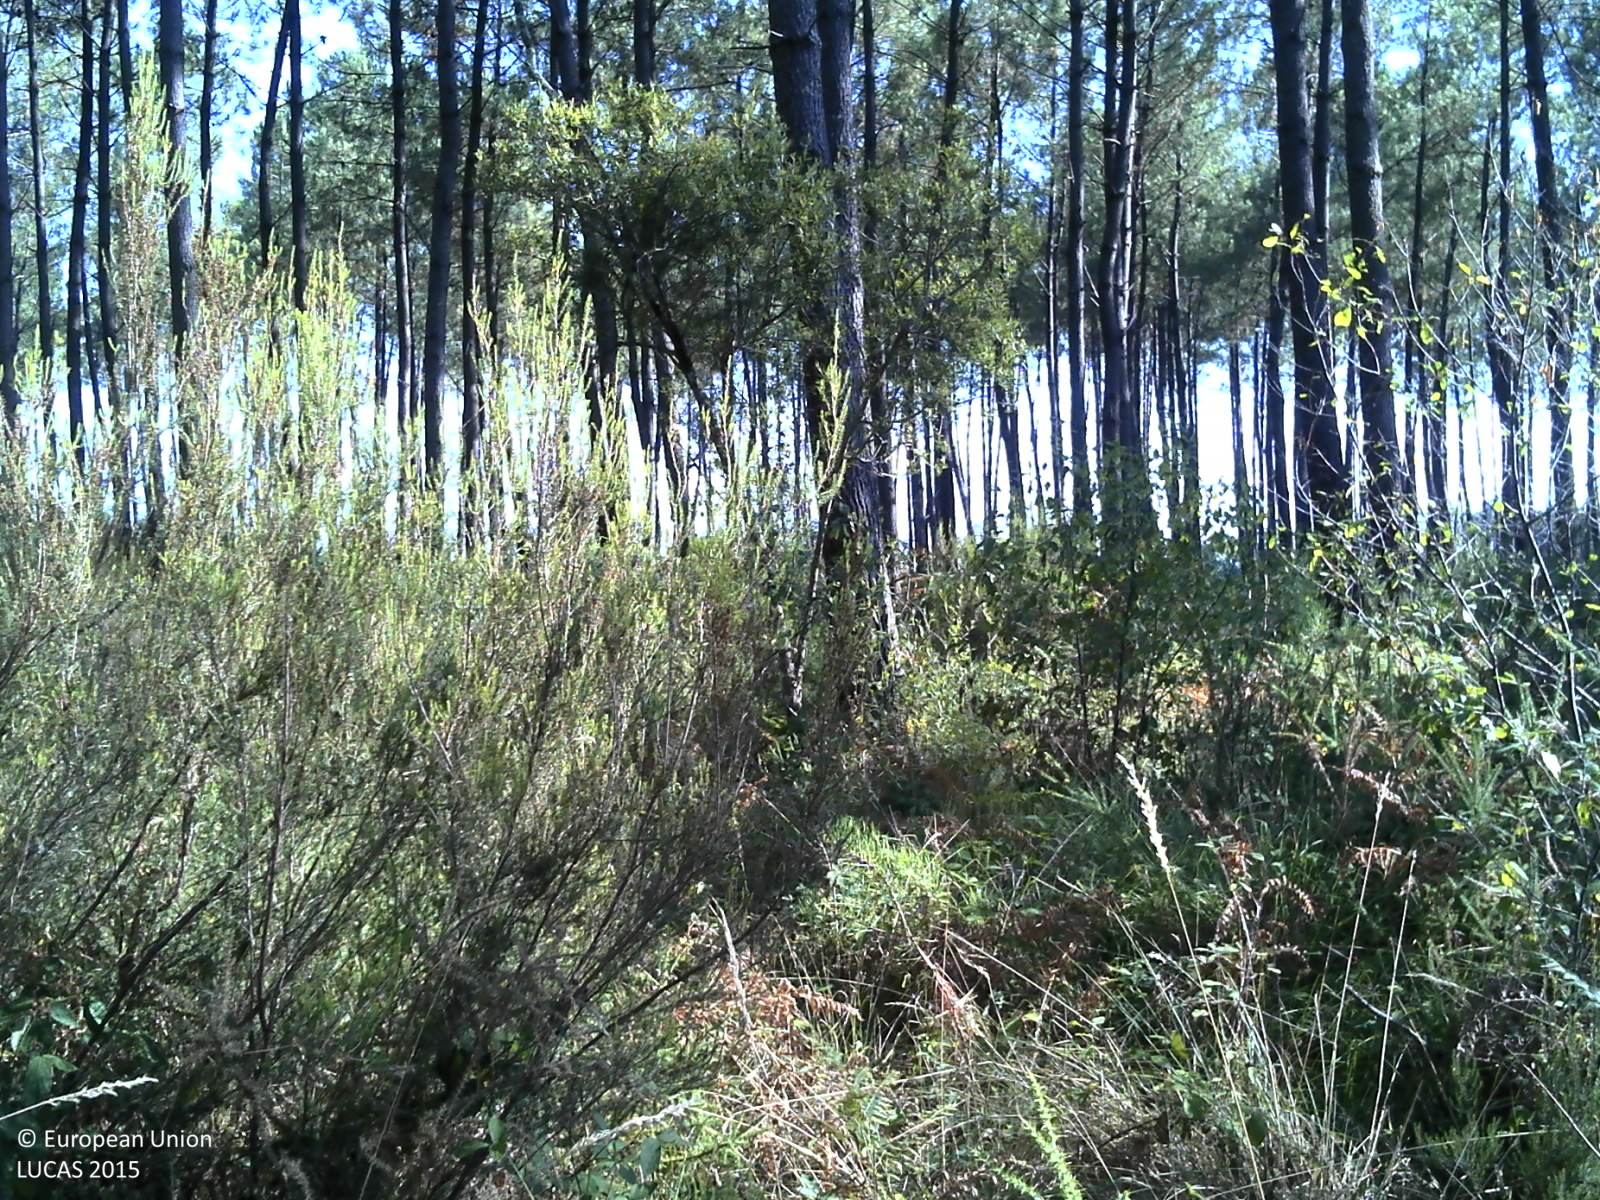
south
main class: Woodland
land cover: Pine dominated coniferous woodland
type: coniferous forest of the mediterranean region
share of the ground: > 75 %
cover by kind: coniferous forest trees 60 %, shrubs 30 %, herbaceous plants 5 %, lichens and mosses 5 %
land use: Forestry
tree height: > 5 m
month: August
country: FR
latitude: 44.5407
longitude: -0.7032
